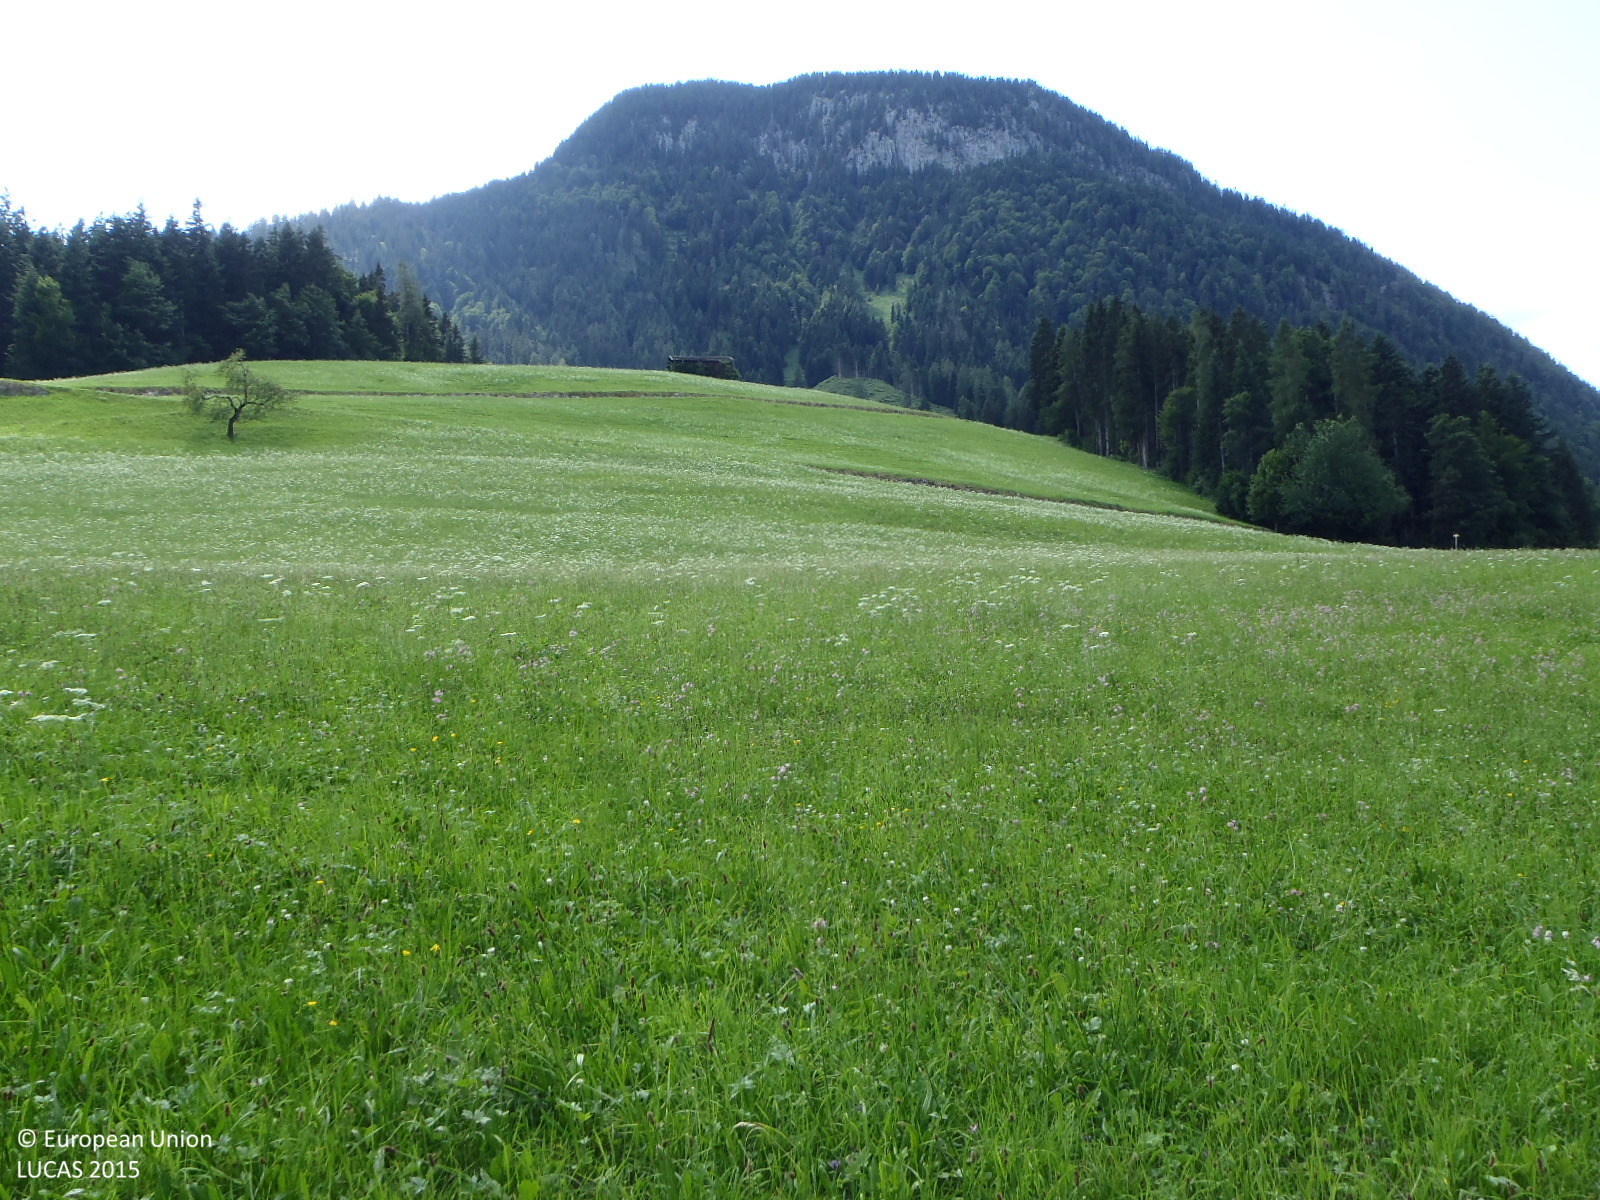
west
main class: Grassland
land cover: Grassland without tree/shrub cover
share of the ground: > 75 %
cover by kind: herbaceous plants 100 %
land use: Agriculture (excluding fallow land and kitchen gardens)
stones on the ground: < 10 %
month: July
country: AT
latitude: 47.5177
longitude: 12.1896
